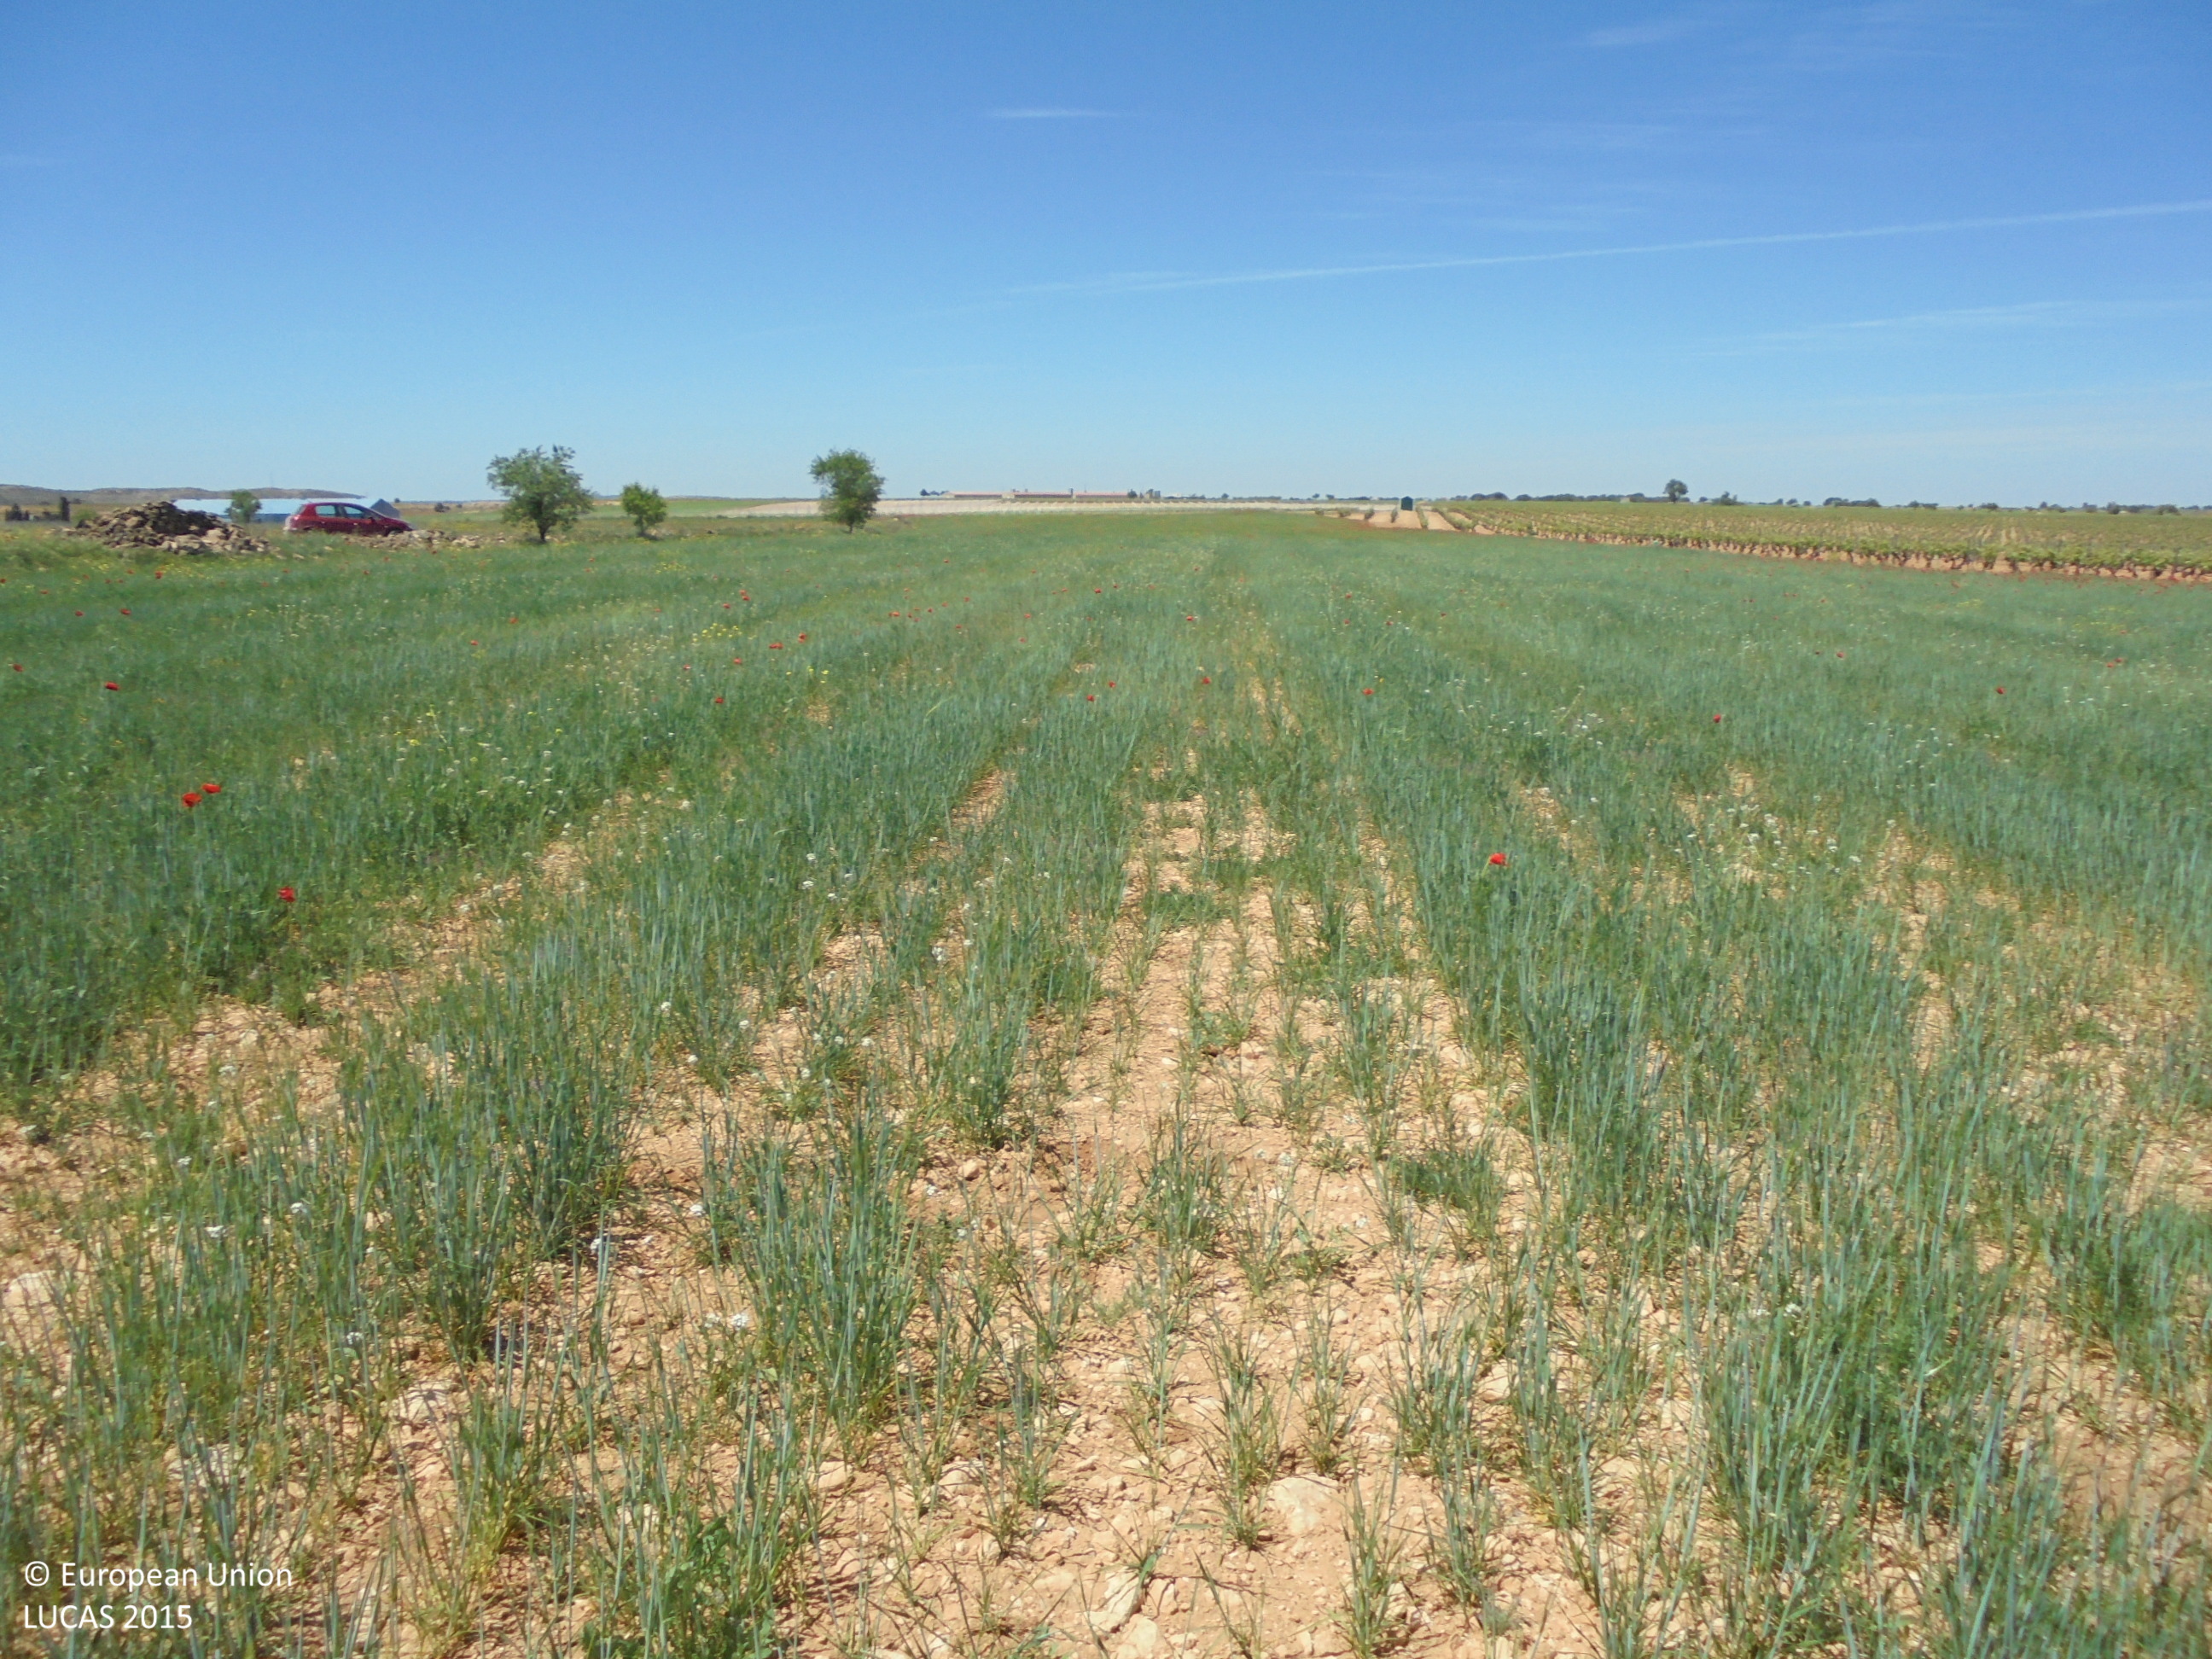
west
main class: Cropland
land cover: Barley
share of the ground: 25 - 50 %
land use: Agriculture (excluding fallow land and kitchen gardens)
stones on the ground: > 50 %
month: May
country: ES
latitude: 39.2768
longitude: -1.5123
